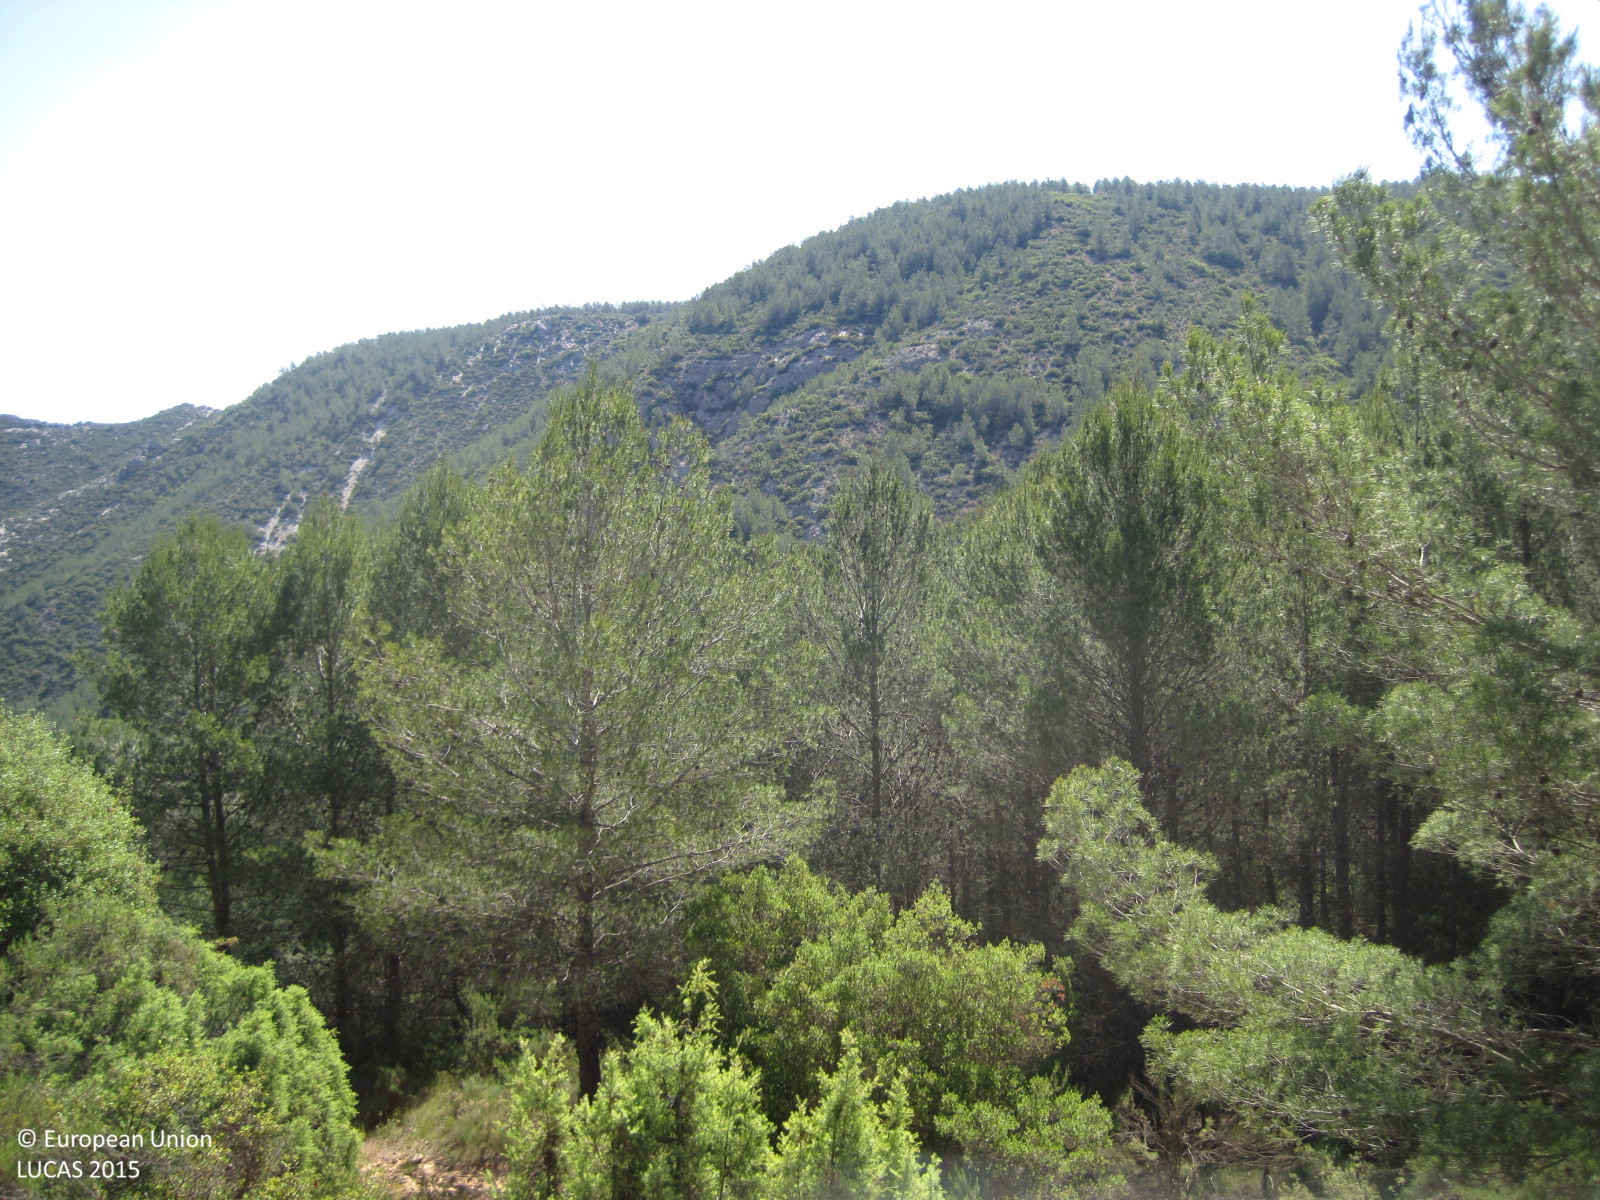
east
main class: Woodland
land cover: Pine dominated coniferous woodland
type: coniferous forest of the mediterranean region
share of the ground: 10 - 25 %
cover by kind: shrubs 50 %, unconsolidated bare surface 20 %, coniferous forest trees 15 %, herbaceous plants 15 %
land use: Forestry
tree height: > 5 m
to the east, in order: Pine dominated coniferous woodland; Tracks; Pine dominated coniferous woodland; Shrubland with sparse tree cover; Pine dominated coniferous woodland
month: June
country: ES
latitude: 39.7394
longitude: -1.1483
